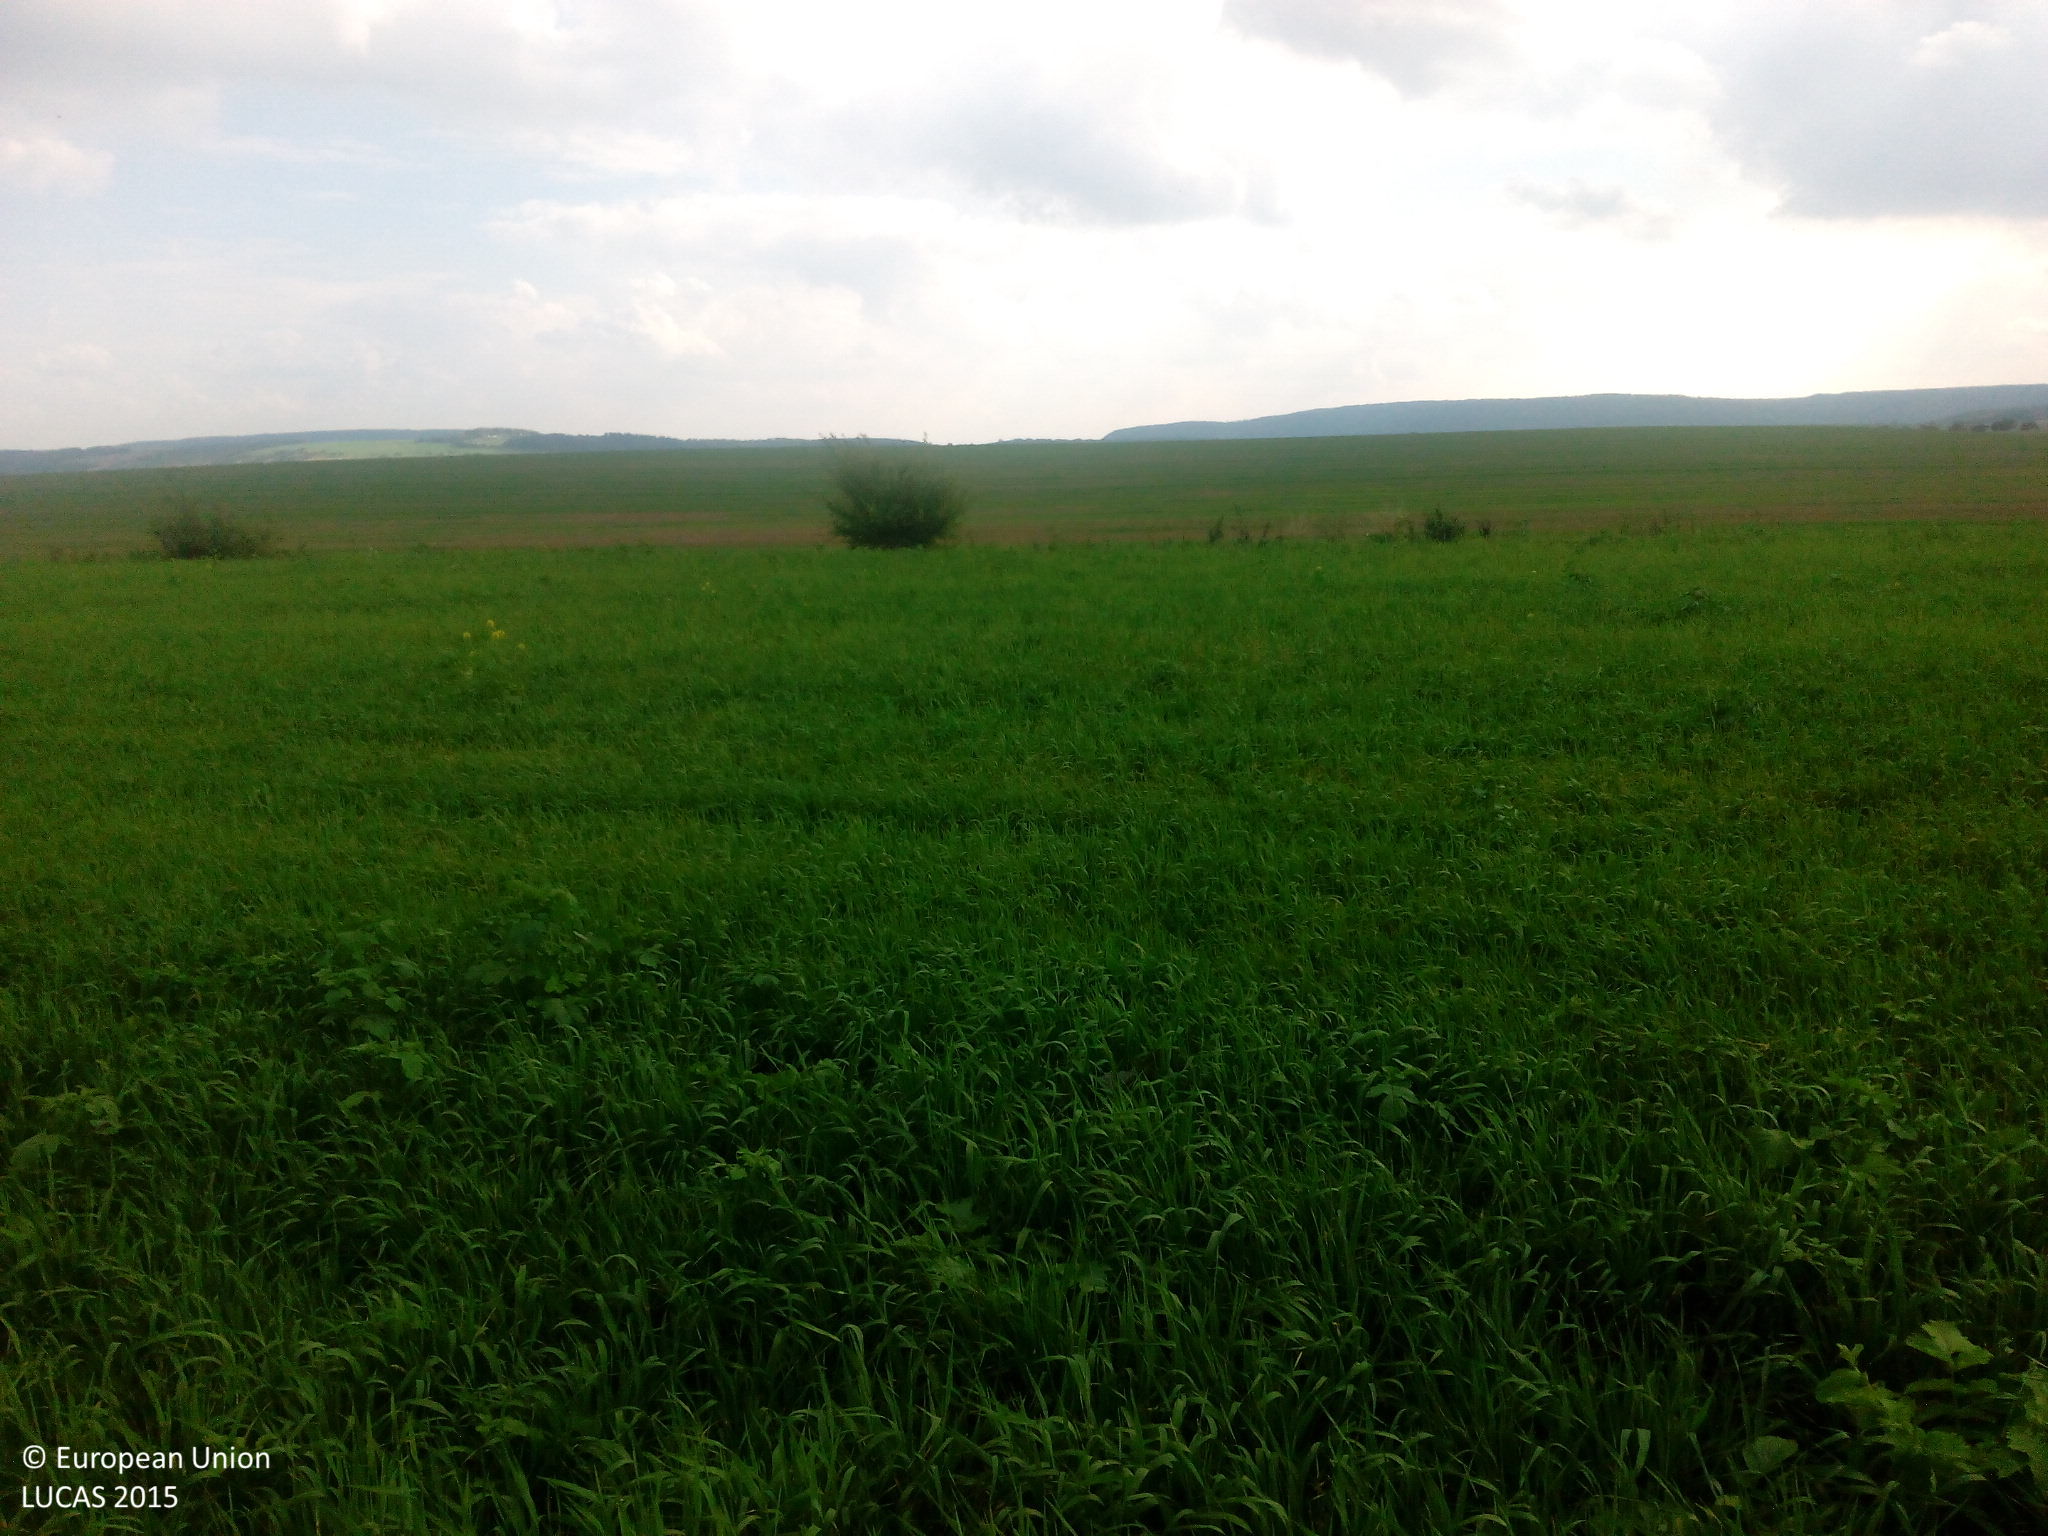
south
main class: Cropland
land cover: Temporary grasslands
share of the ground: > 75 %
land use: Agriculture (excluding fallow land and kitchen gardens)
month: September
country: DE
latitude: 51.3844
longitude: 11.0199
